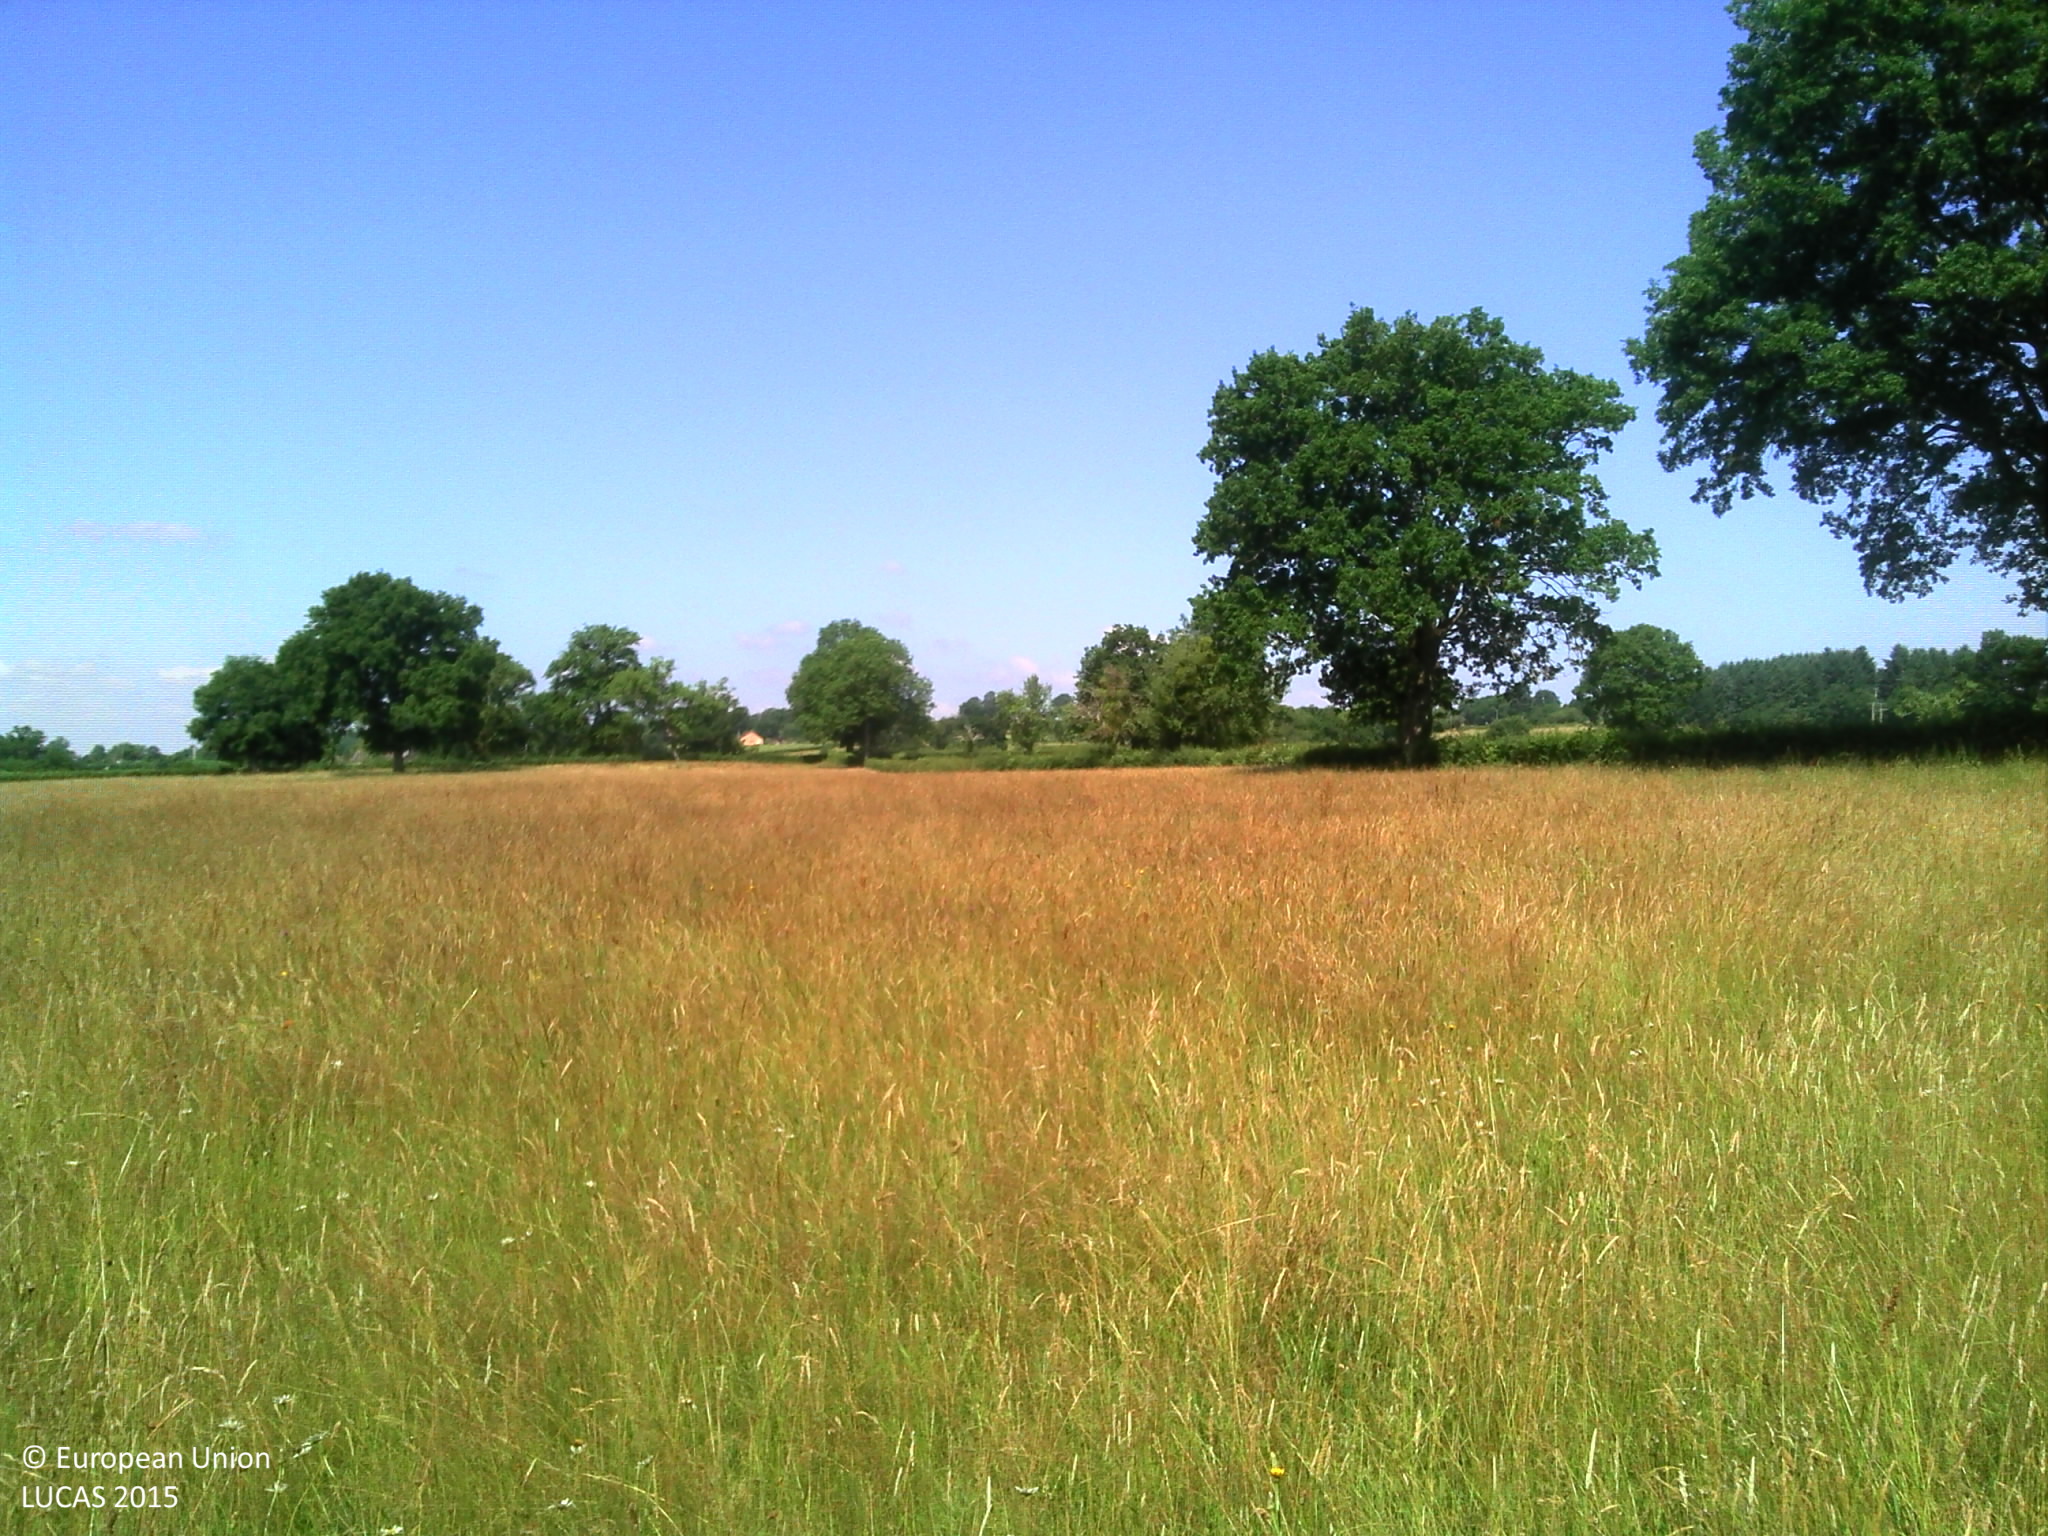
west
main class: Grassland
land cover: Grassland without tree/shrub cover
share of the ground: > 75 %
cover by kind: herbaceous plants 100 %
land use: Agriculture (excluding fallow land and kitchen gardens)
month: June
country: FR
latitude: 46.4567
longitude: 4.3896
